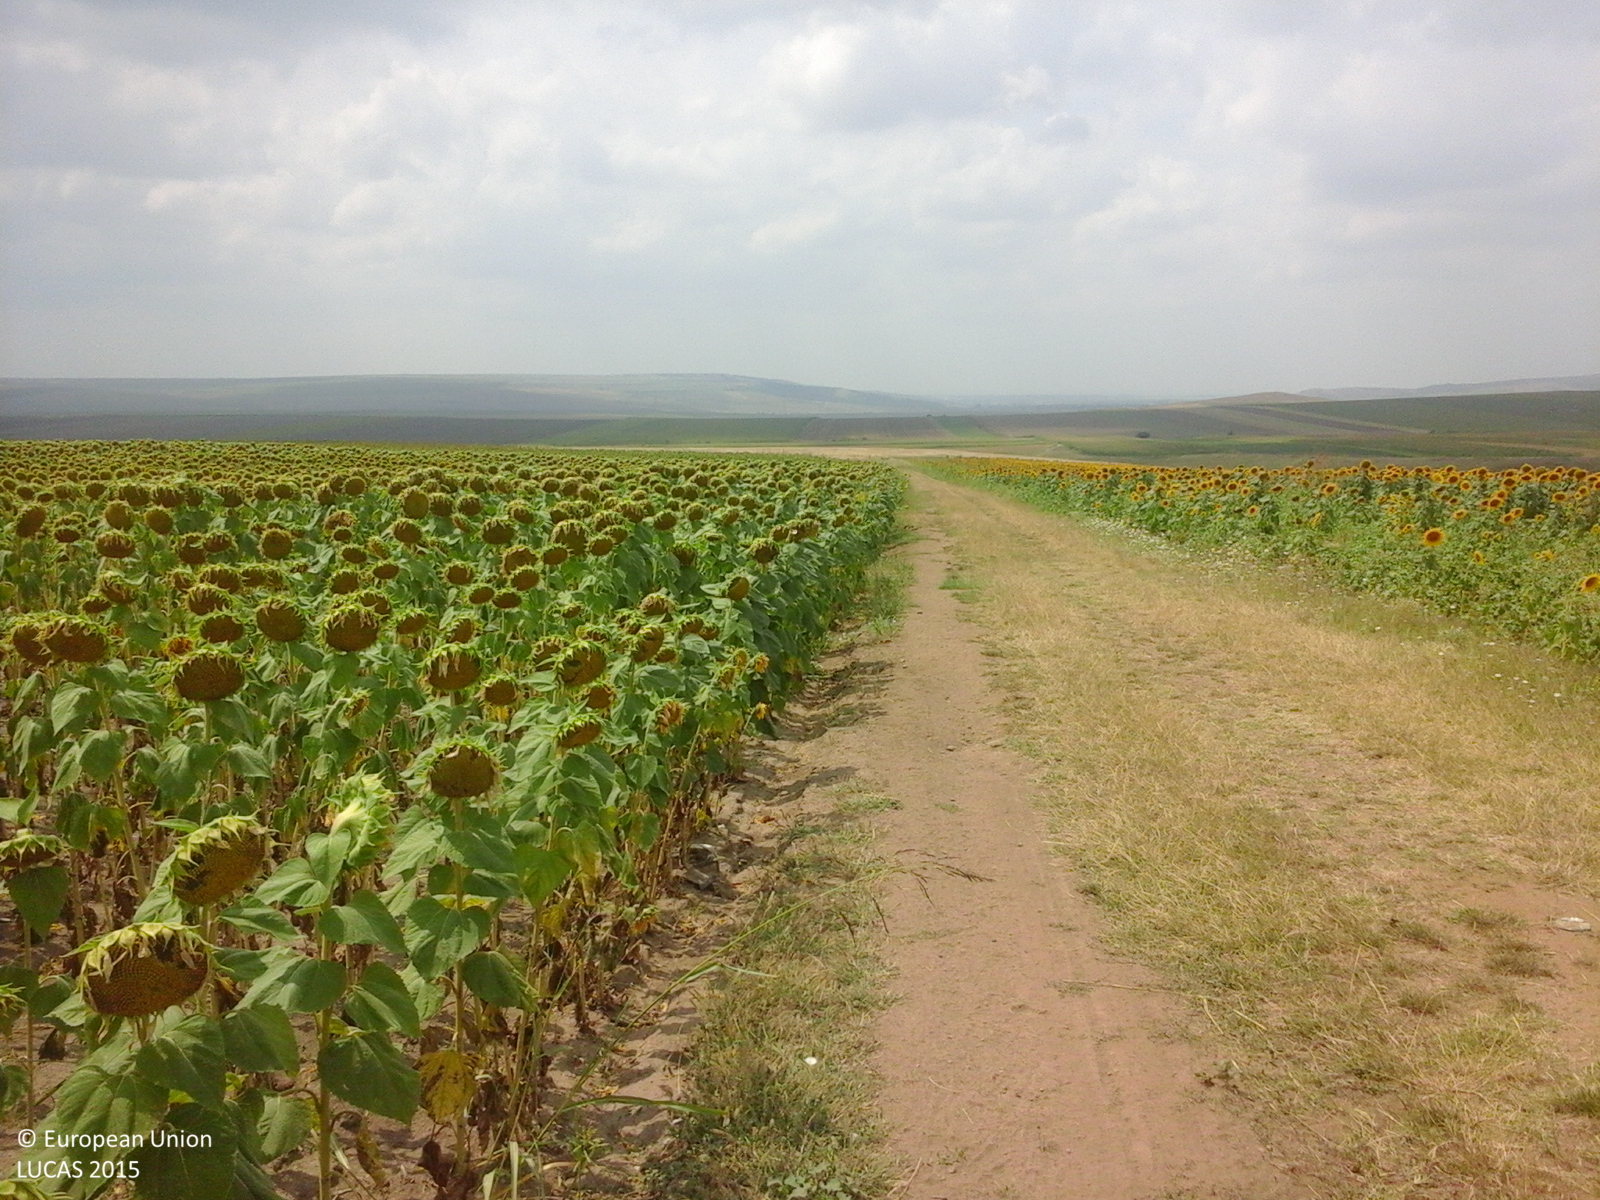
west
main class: Cropland
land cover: Sunflower
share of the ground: > 75 %
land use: Agriculture (excluding fallow land and kitchen gardens)
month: July
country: RO
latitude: 44.8815
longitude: 28.3137
